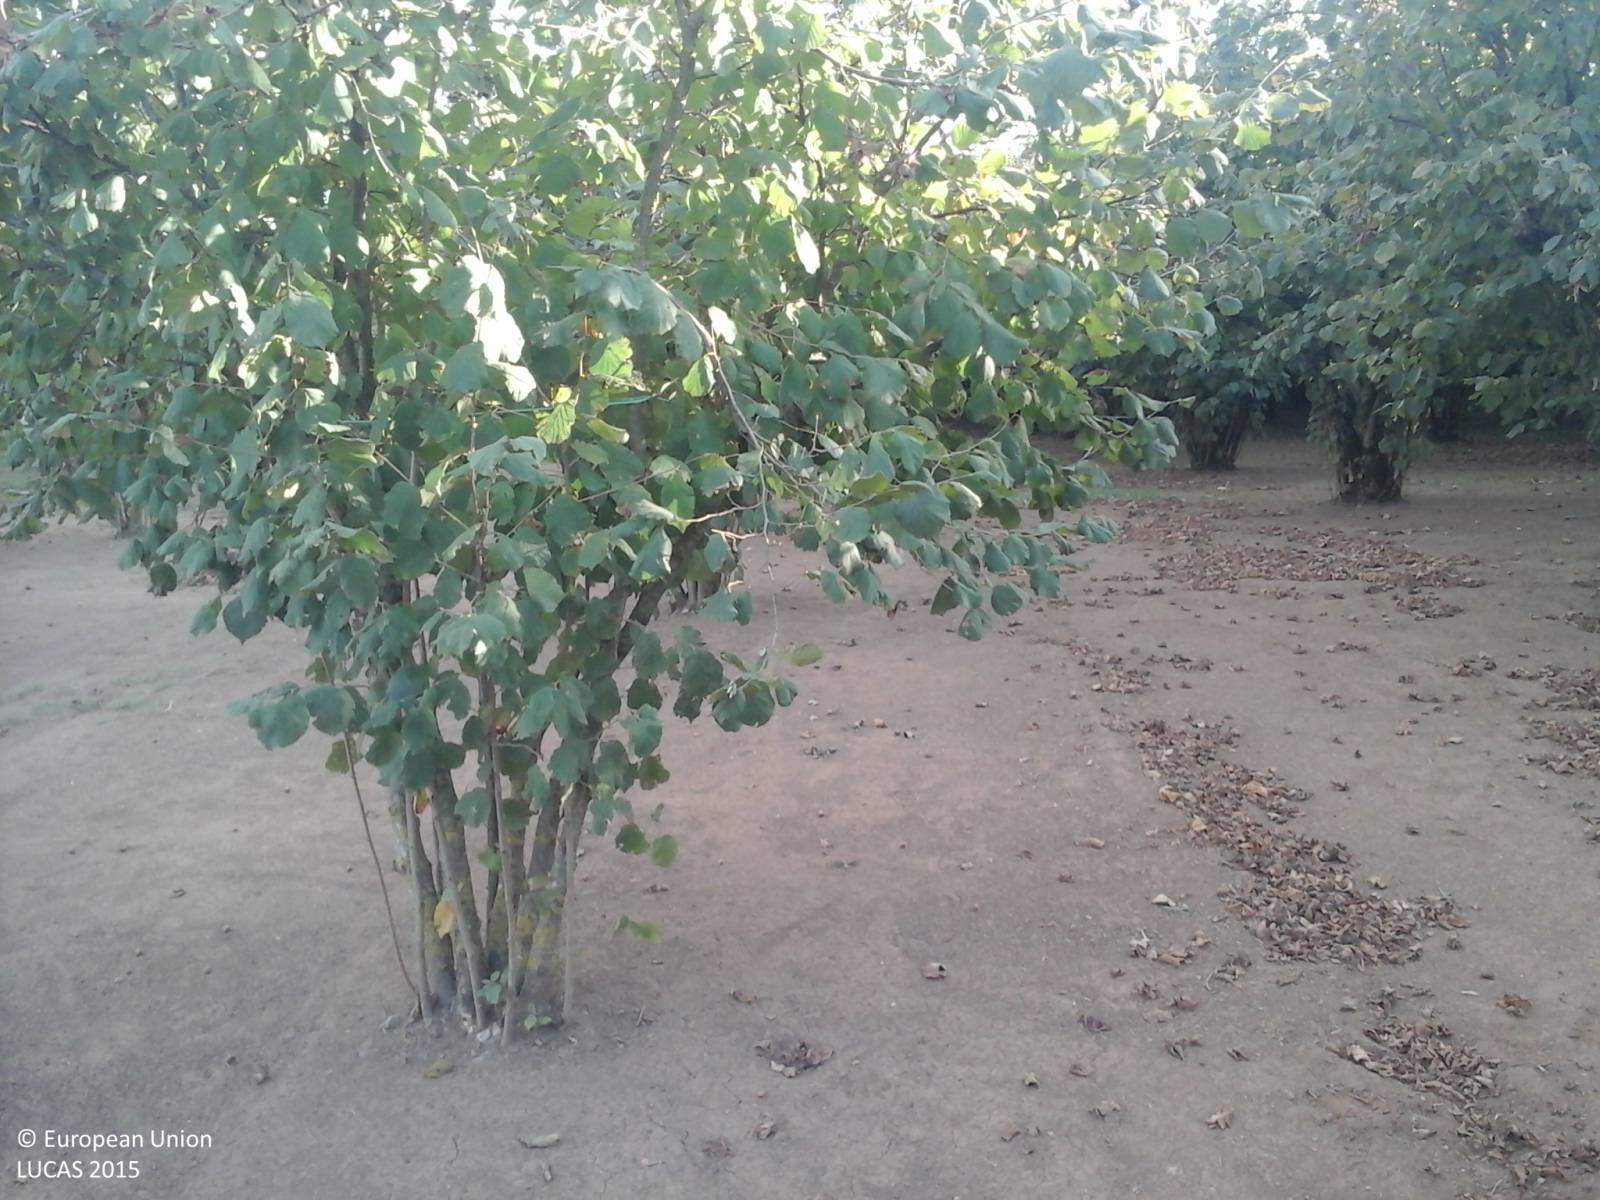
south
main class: Cropland
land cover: Nuts trees
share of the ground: > 75 %
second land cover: Other bare soil
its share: > 75 %
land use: Agriculture (excluding fallow land and kitchen gardens)
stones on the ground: < 10 %
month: September
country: IT
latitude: 42.3927
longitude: 12.3124
